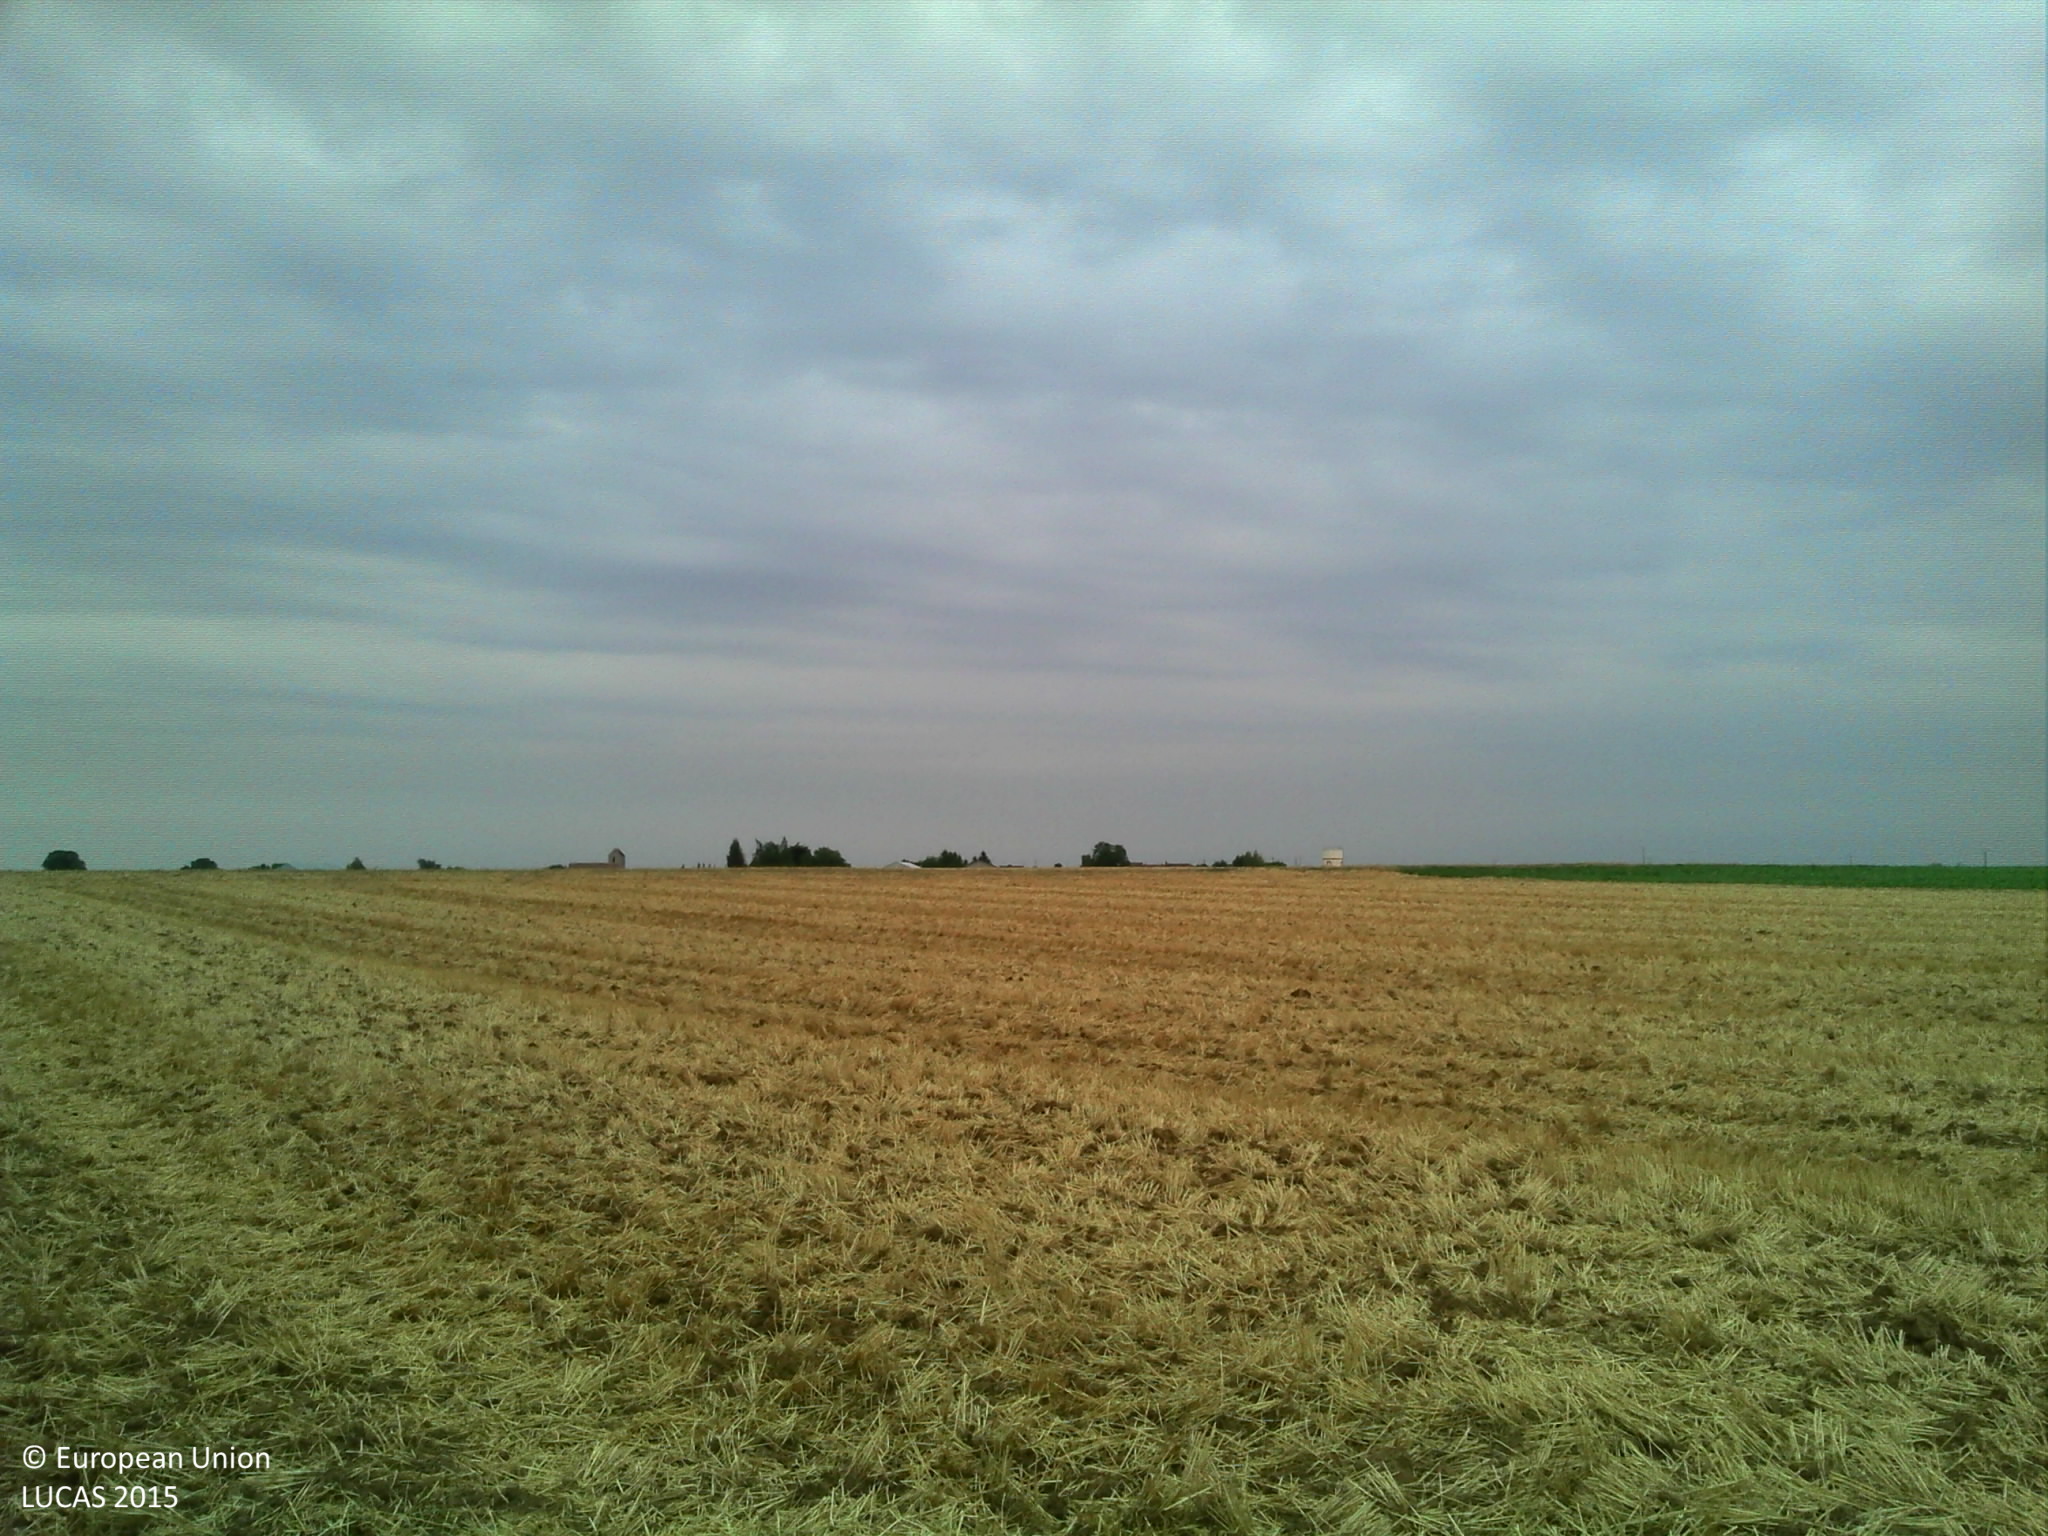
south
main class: Cropland
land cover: Common wheat
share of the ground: 10 - 25 %
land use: Agriculture (excluding fallow land and kitchen gardens)
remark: Harvested field
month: August
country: FR
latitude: 48.2419
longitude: 2.5437
